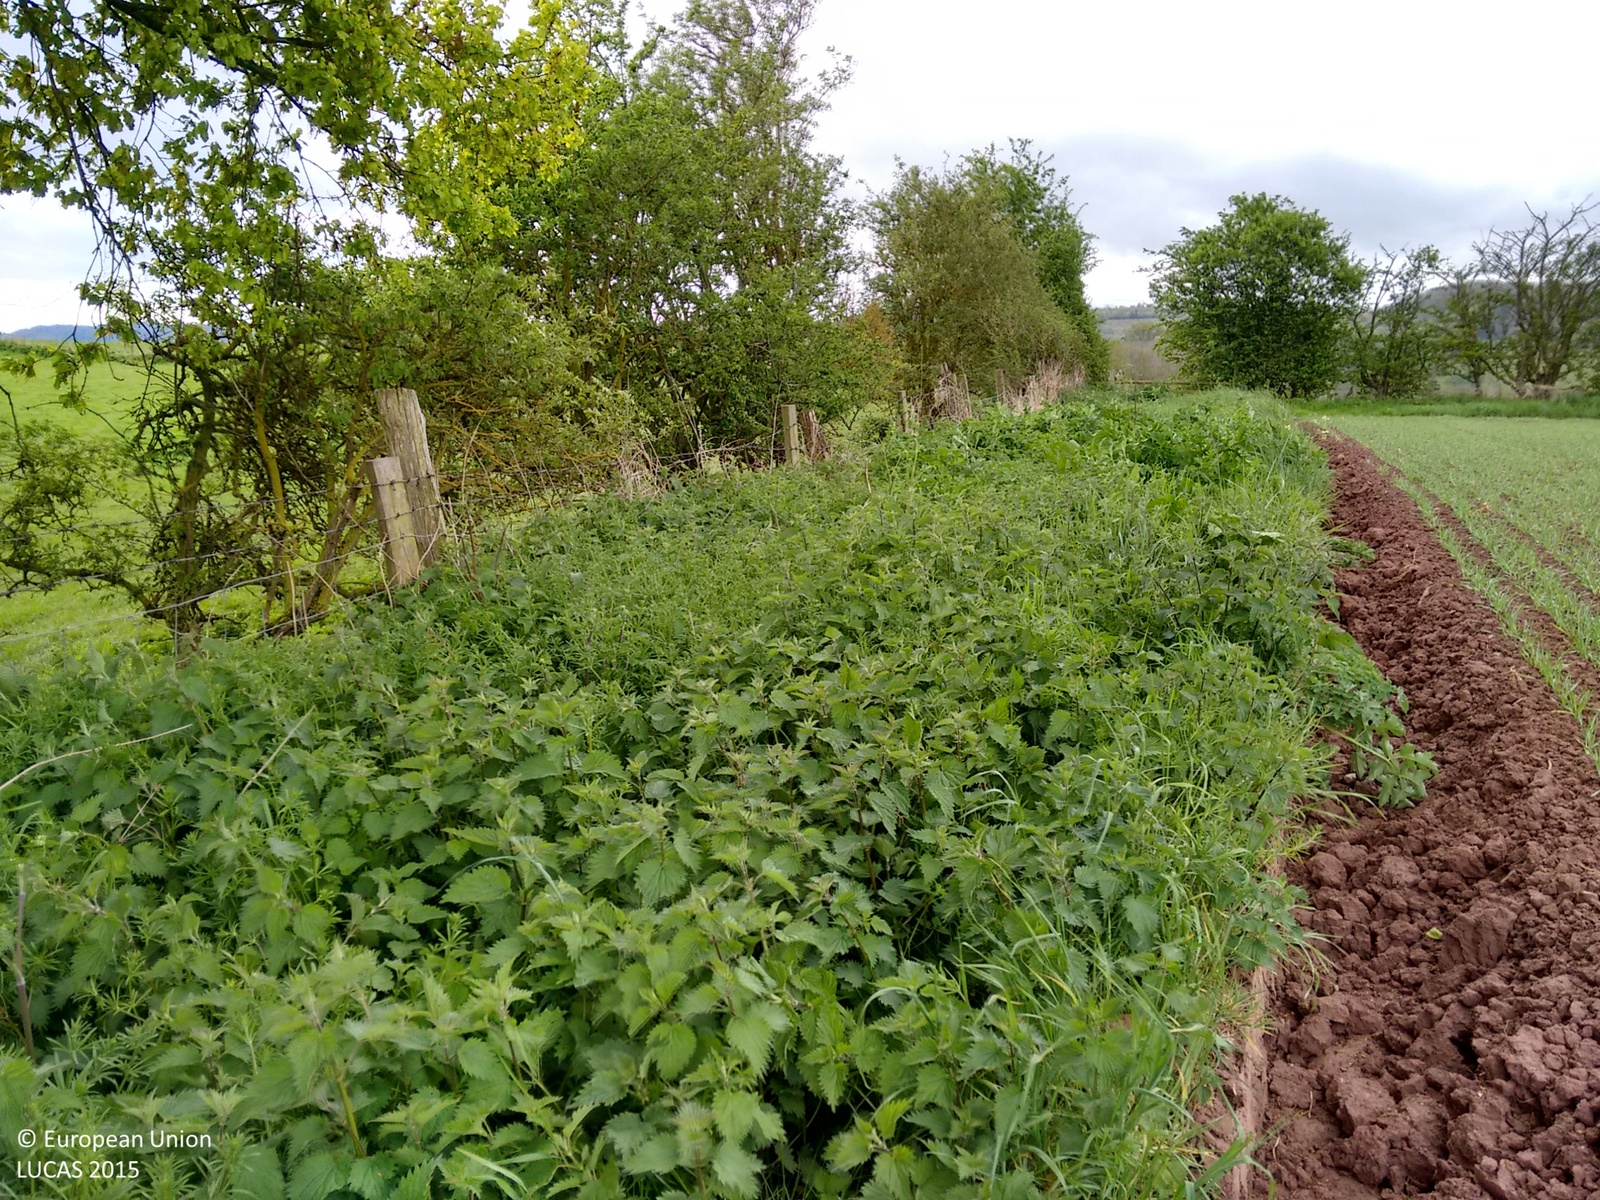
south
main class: Cropland
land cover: Barley
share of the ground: 25 - 50 %
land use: Agriculture (excluding fallow land and kitchen gardens)
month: May
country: GB
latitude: 52.3036
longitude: -2.4281
